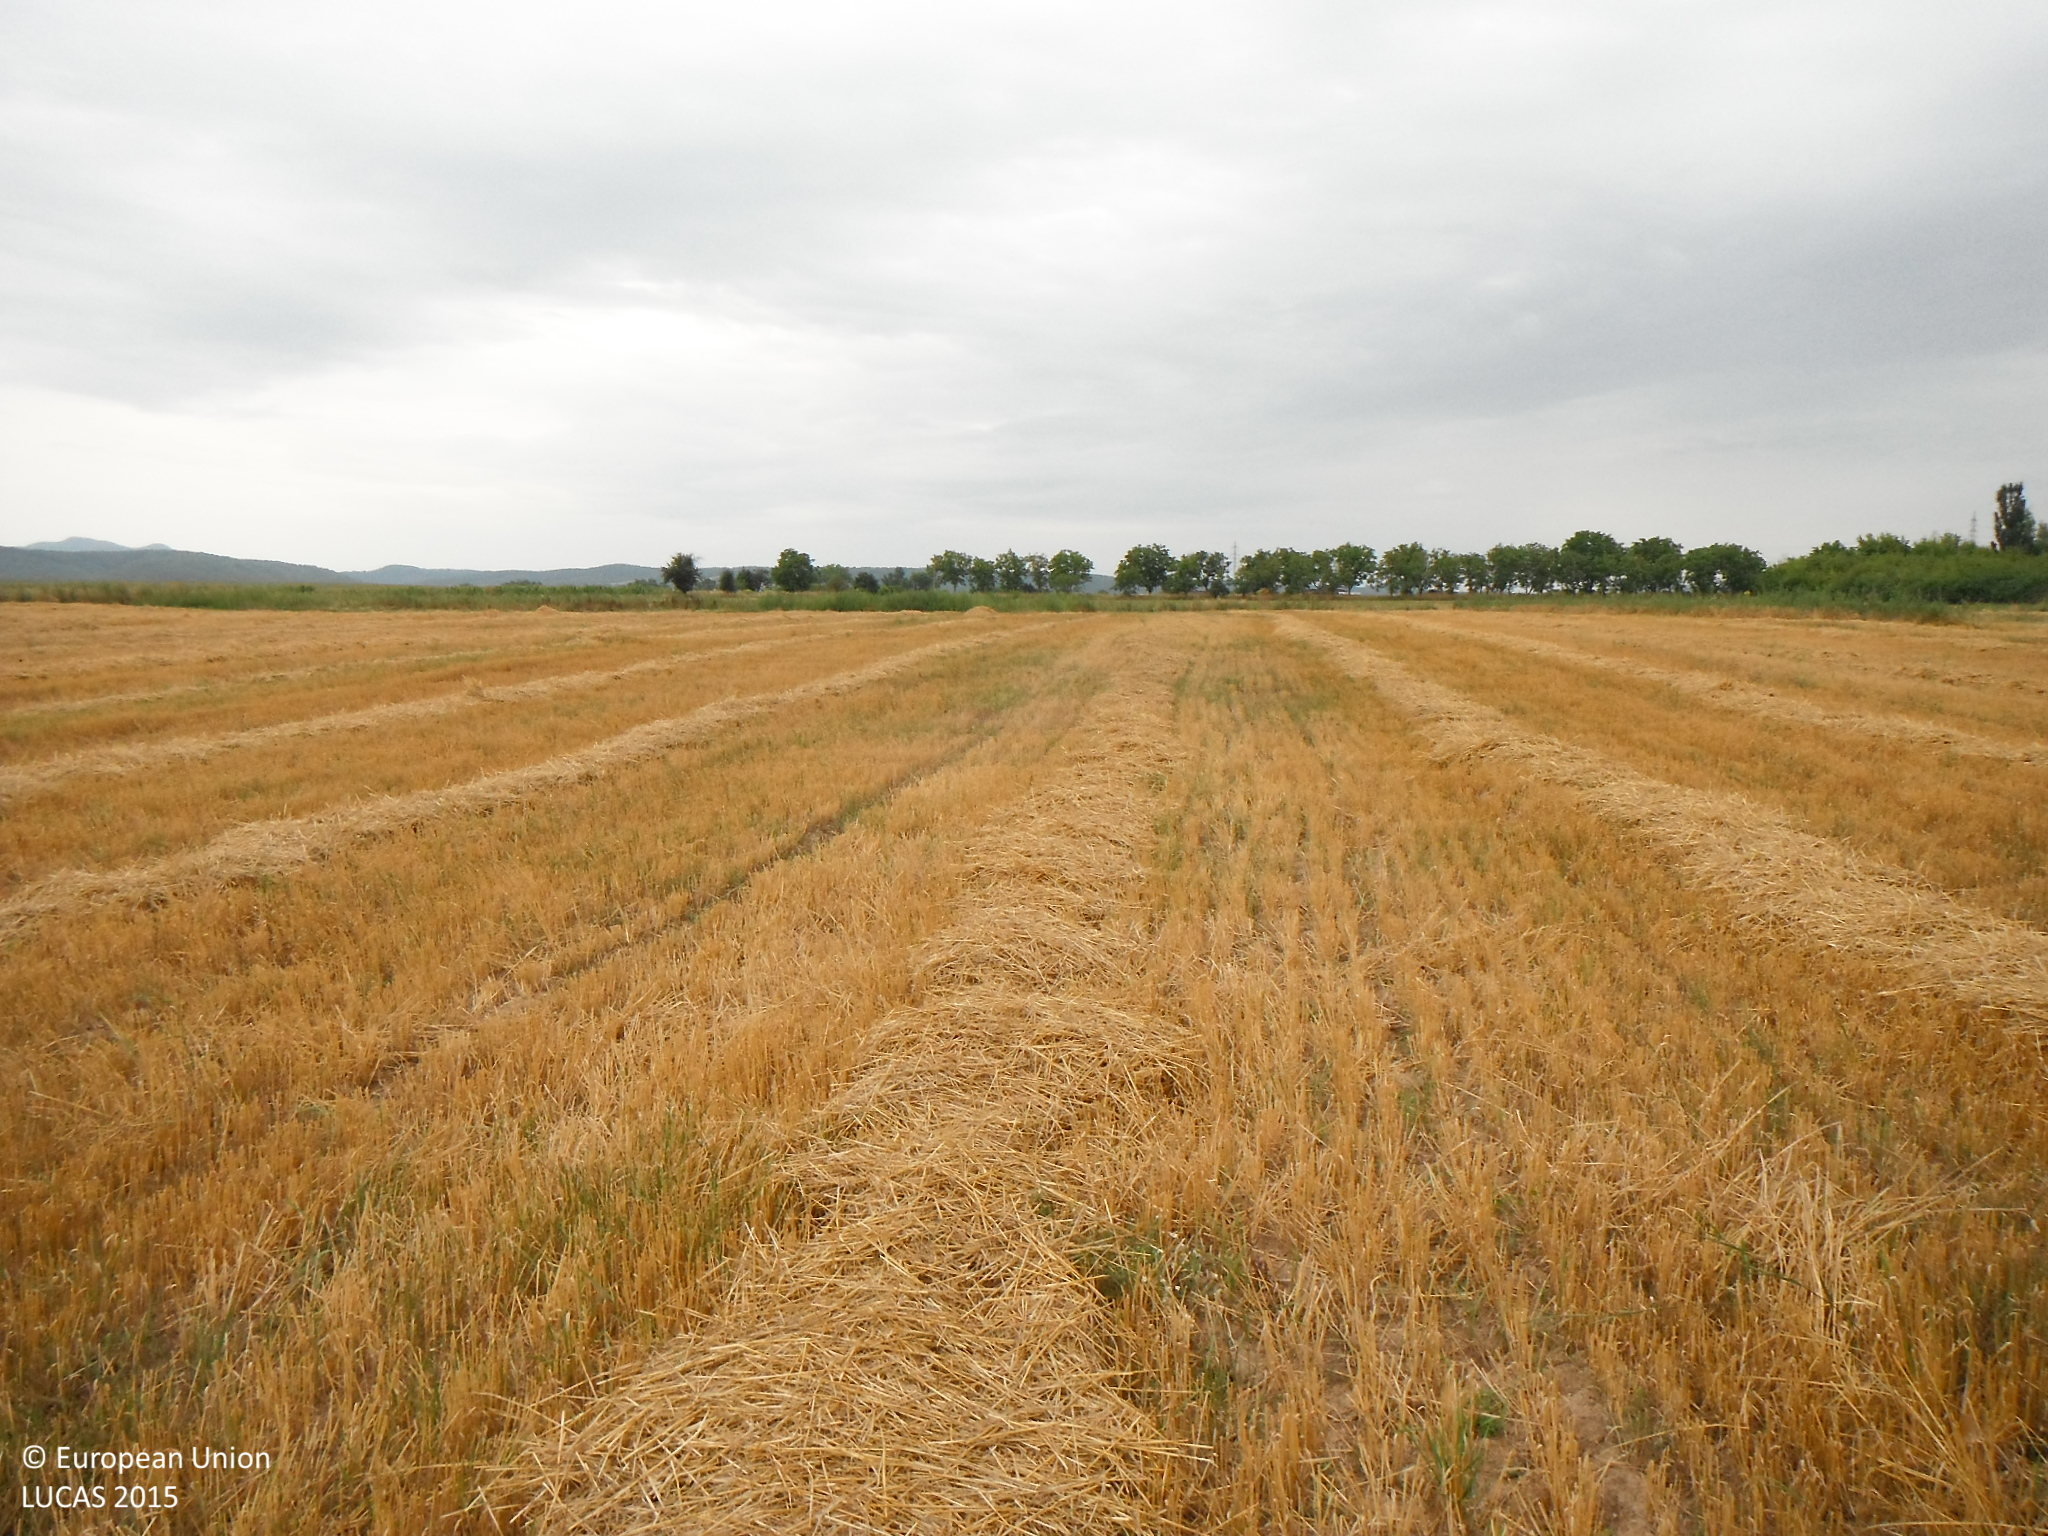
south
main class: Cropland
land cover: Barley
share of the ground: > 75 %
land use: Agriculture (excluding fallow land and kitchen gardens)
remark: Harvested field
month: July
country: SK
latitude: 48.3053
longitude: 19.6655
